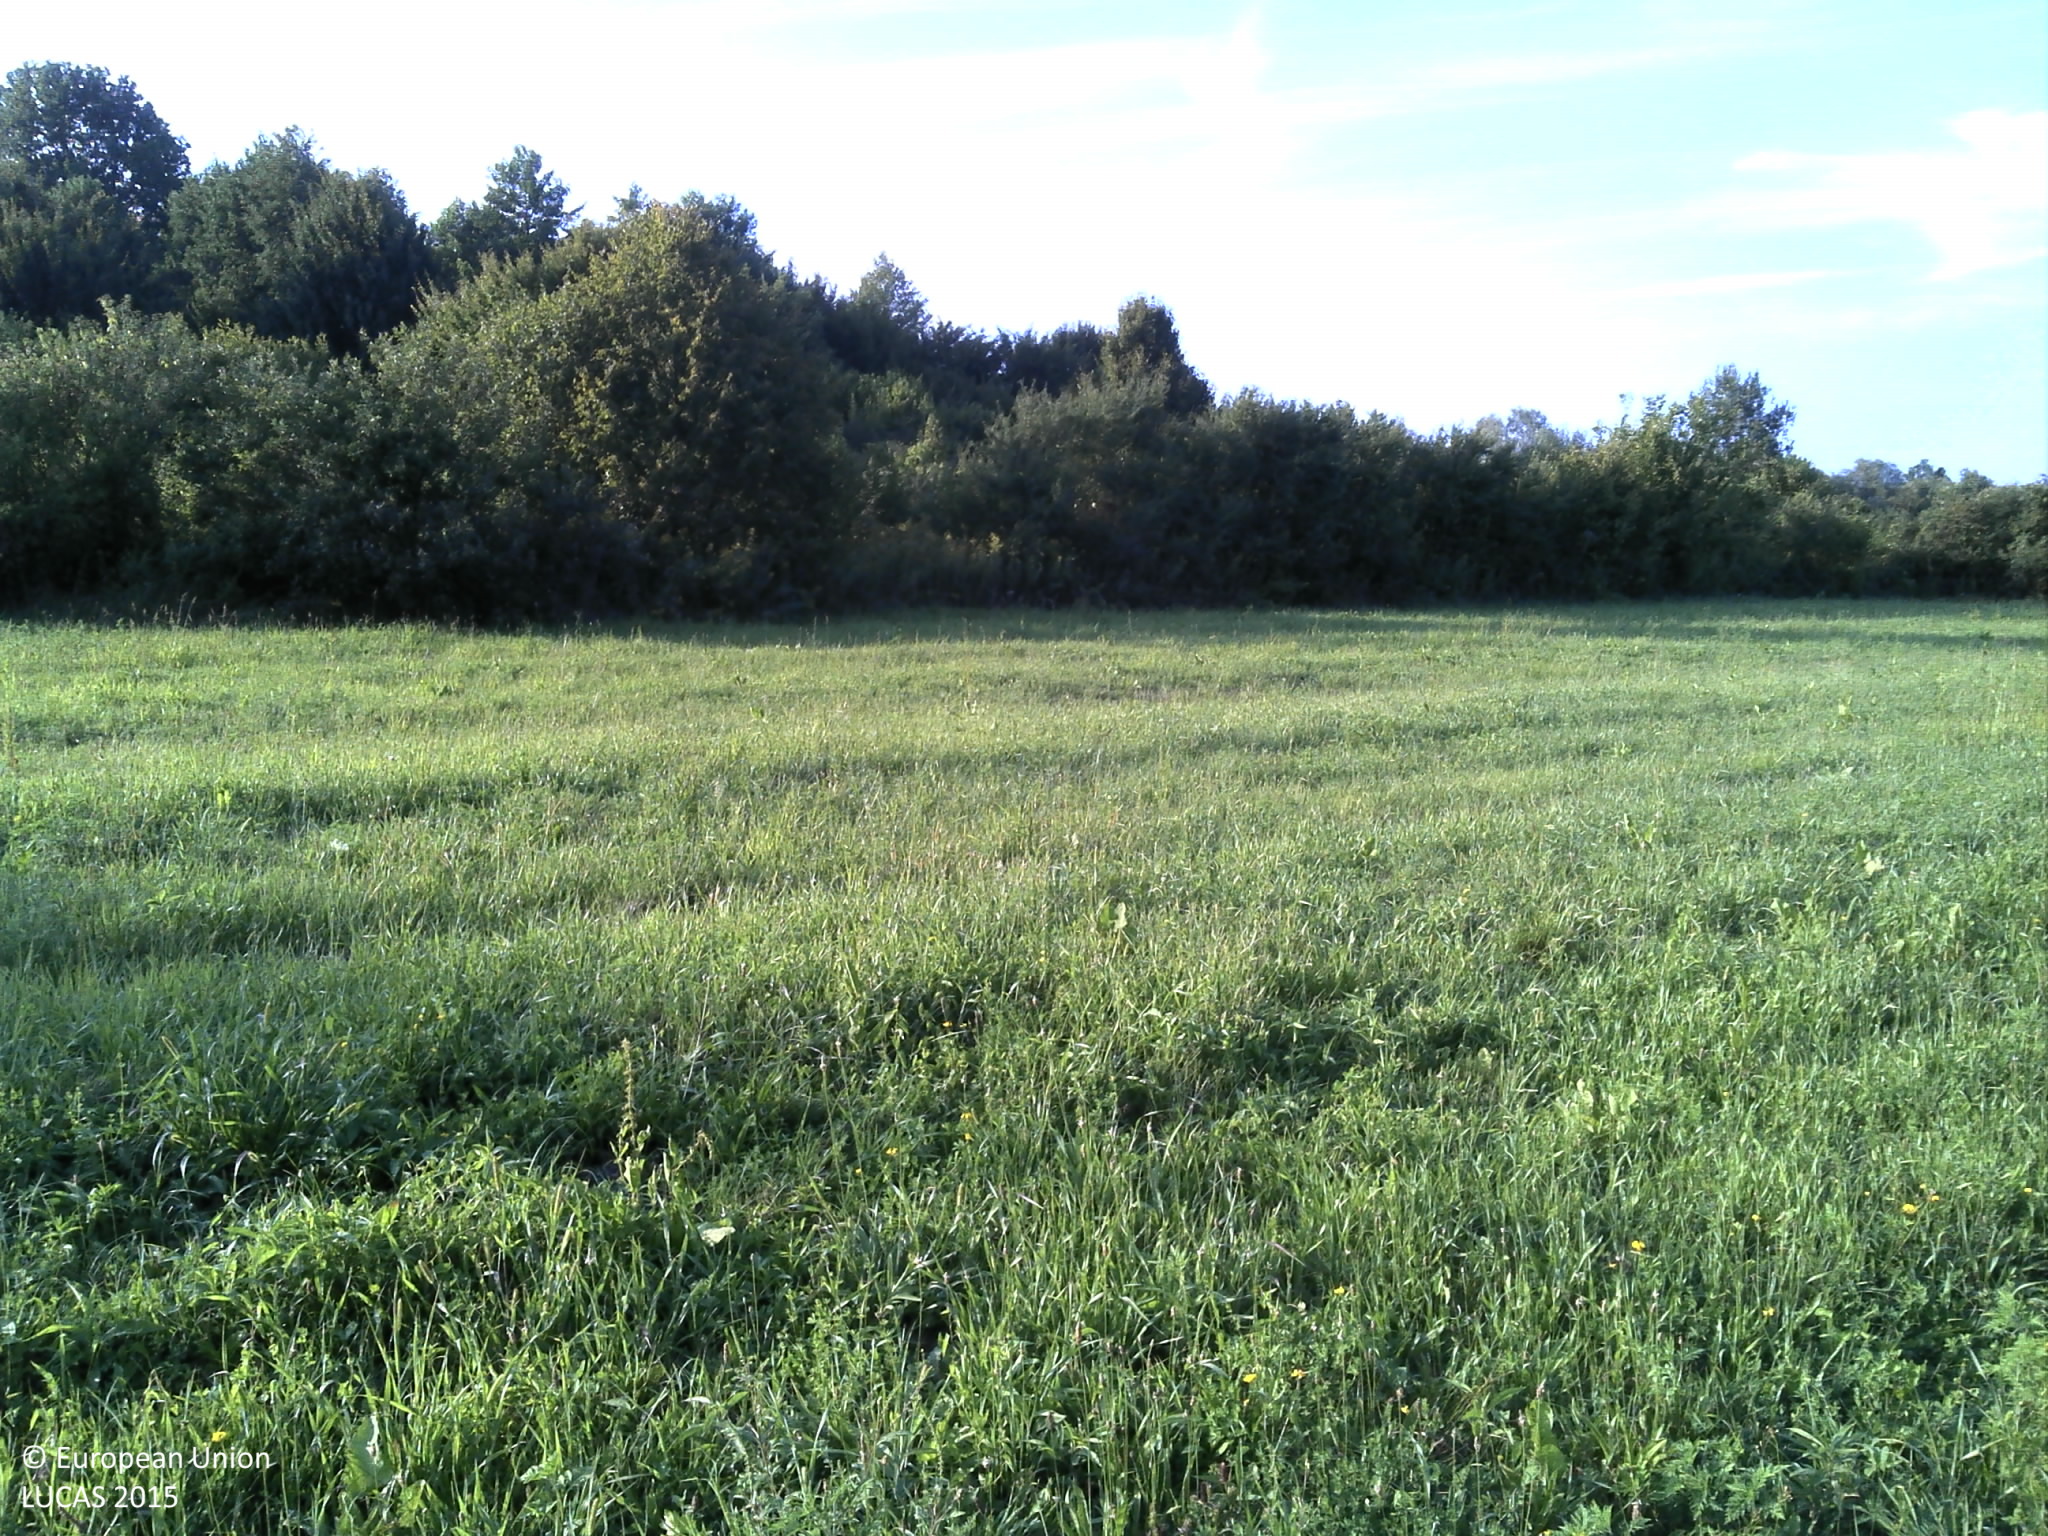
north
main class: Grassland
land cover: Grassland without tree/shrub cover
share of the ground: > 75 %
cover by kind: herbaceous plants 100 %
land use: Semi-natural and natural areas not in use
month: August
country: HR
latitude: 45.2952
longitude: 16.6414
